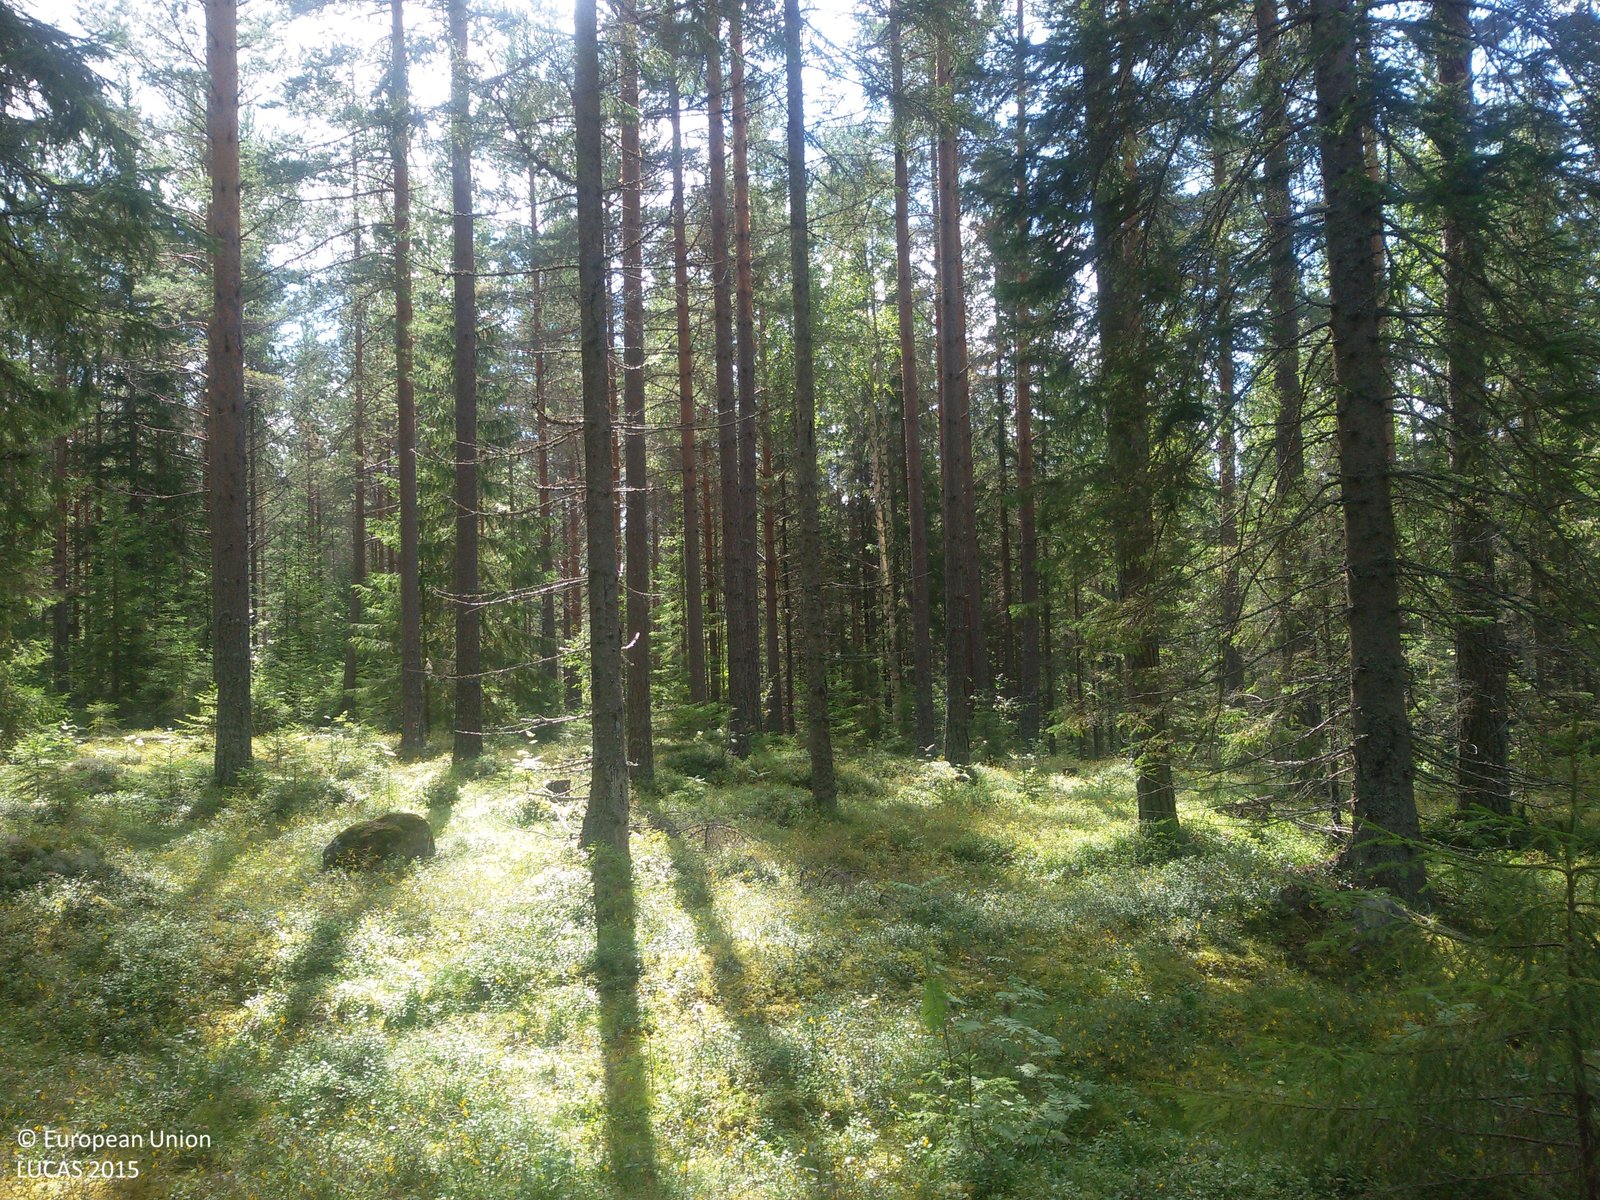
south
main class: Woodland
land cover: Spruce dominated coniferous woodland
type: boreal forest
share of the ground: 50 - 75 %
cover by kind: coniferous forest trees 70 %, herbaceous plants 15 %, lichens and mosses 15 %
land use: Forestry
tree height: > 5 m
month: August
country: SE
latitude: 60.7632
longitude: 16.6871
